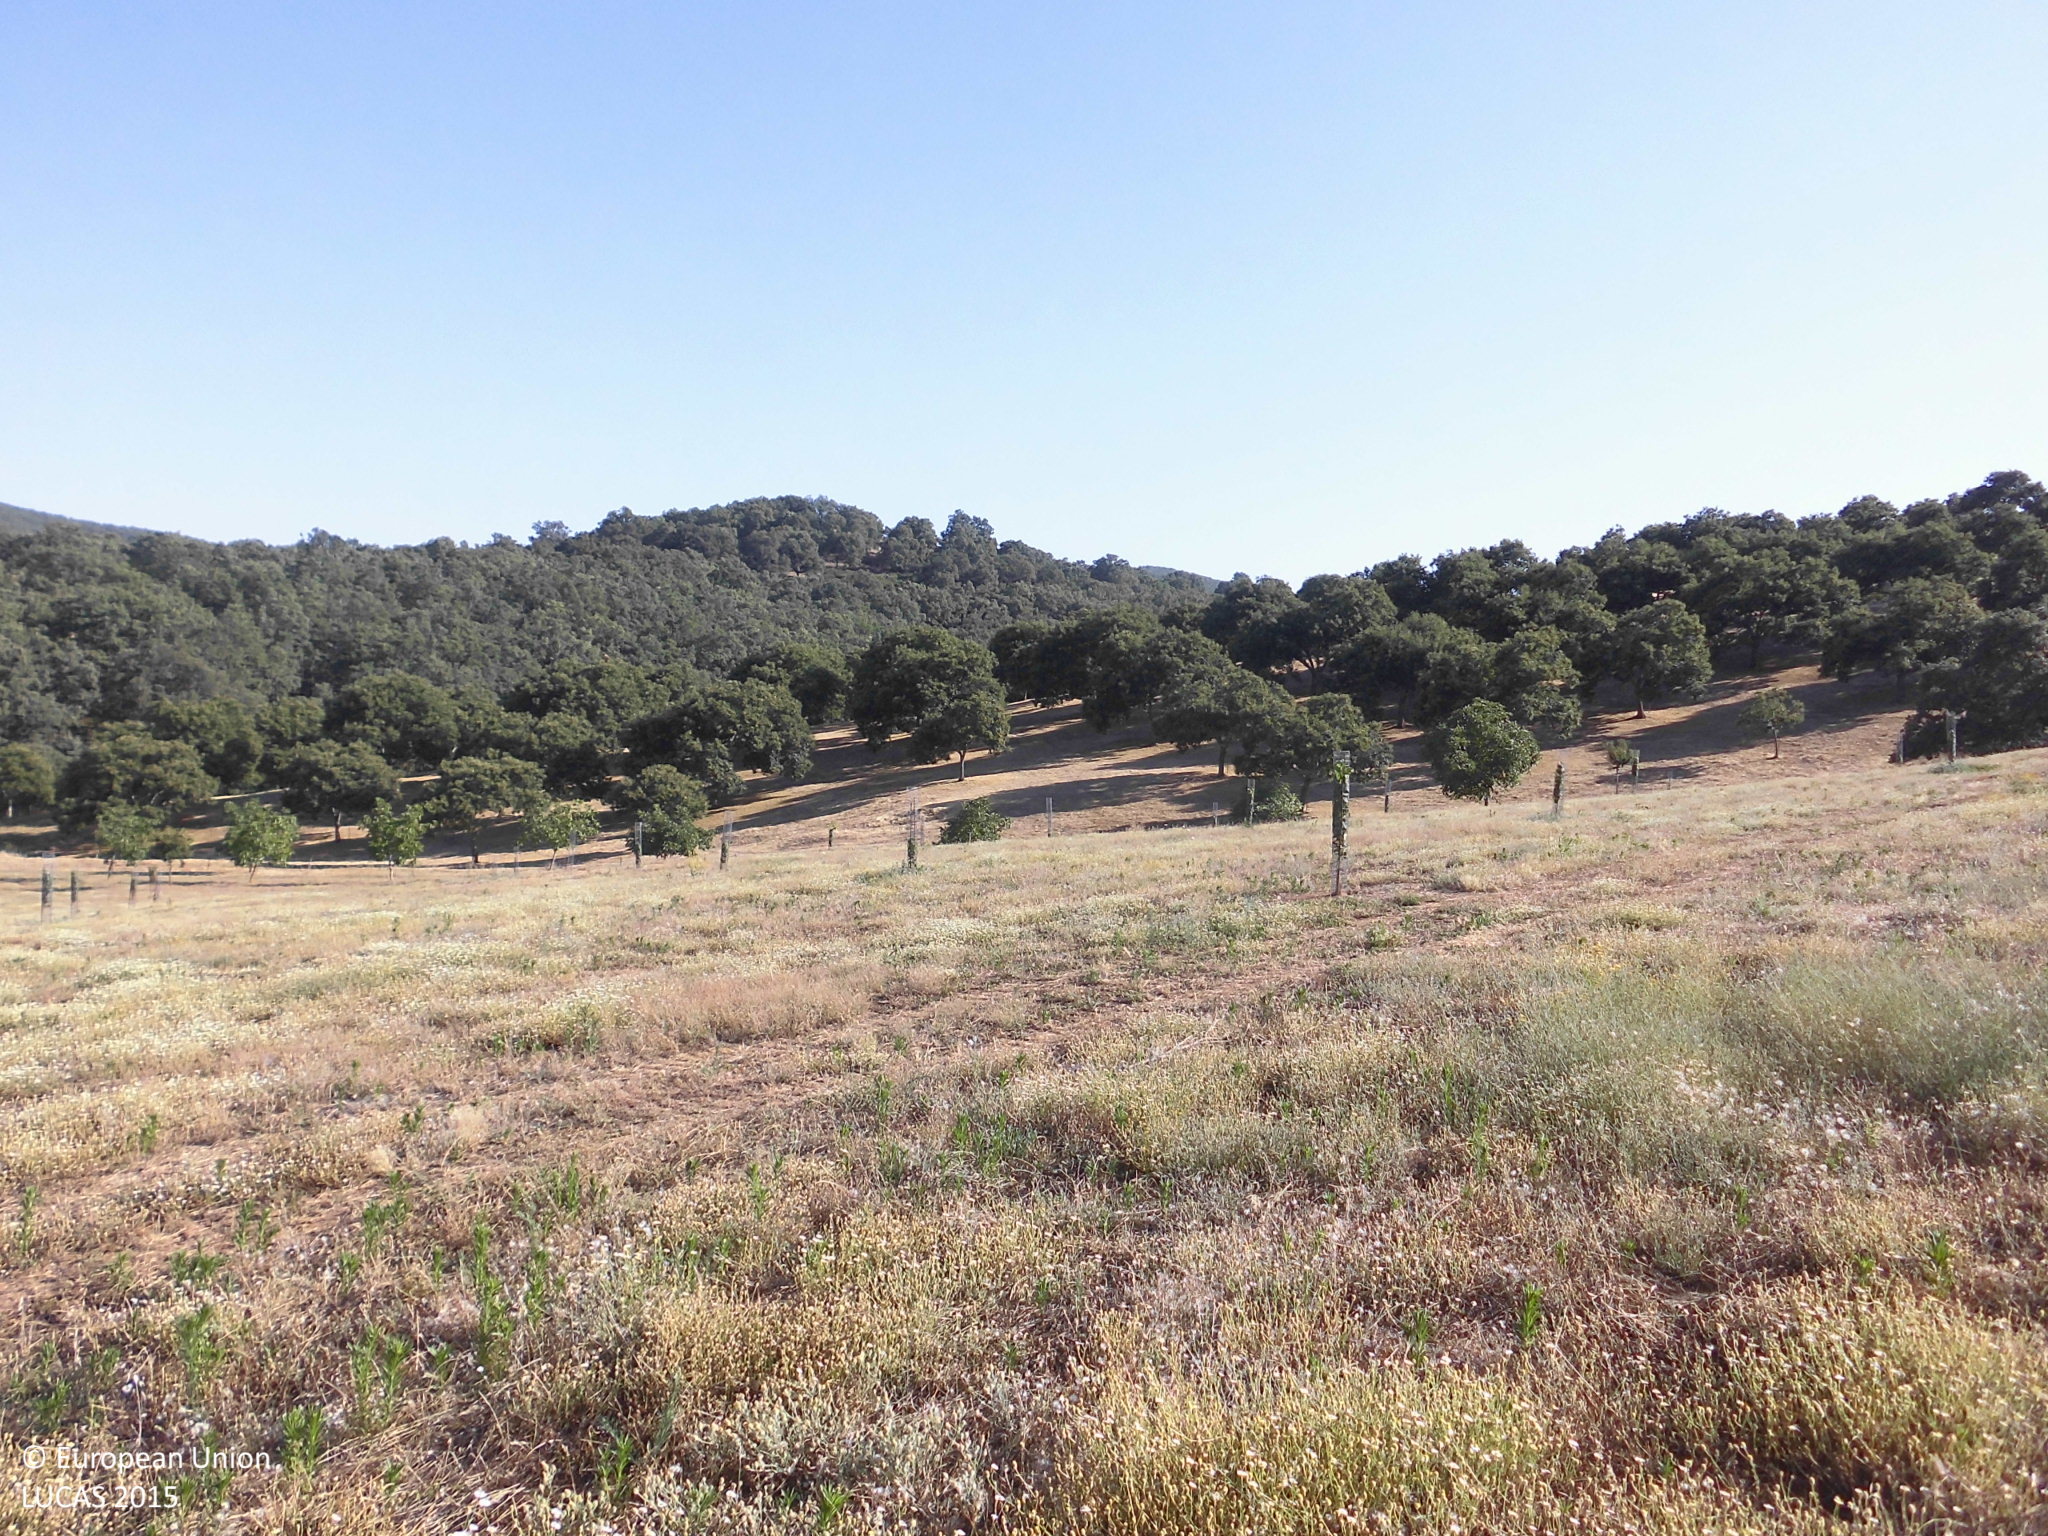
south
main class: Cropland
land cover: Nuts trees
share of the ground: < 10 %
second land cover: Grassland without tree/shrub cover
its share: > 75 %
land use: Agriculture (excluding fallow land and kitchen gardens)
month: July
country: ES
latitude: 39.4044
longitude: -5.5548
